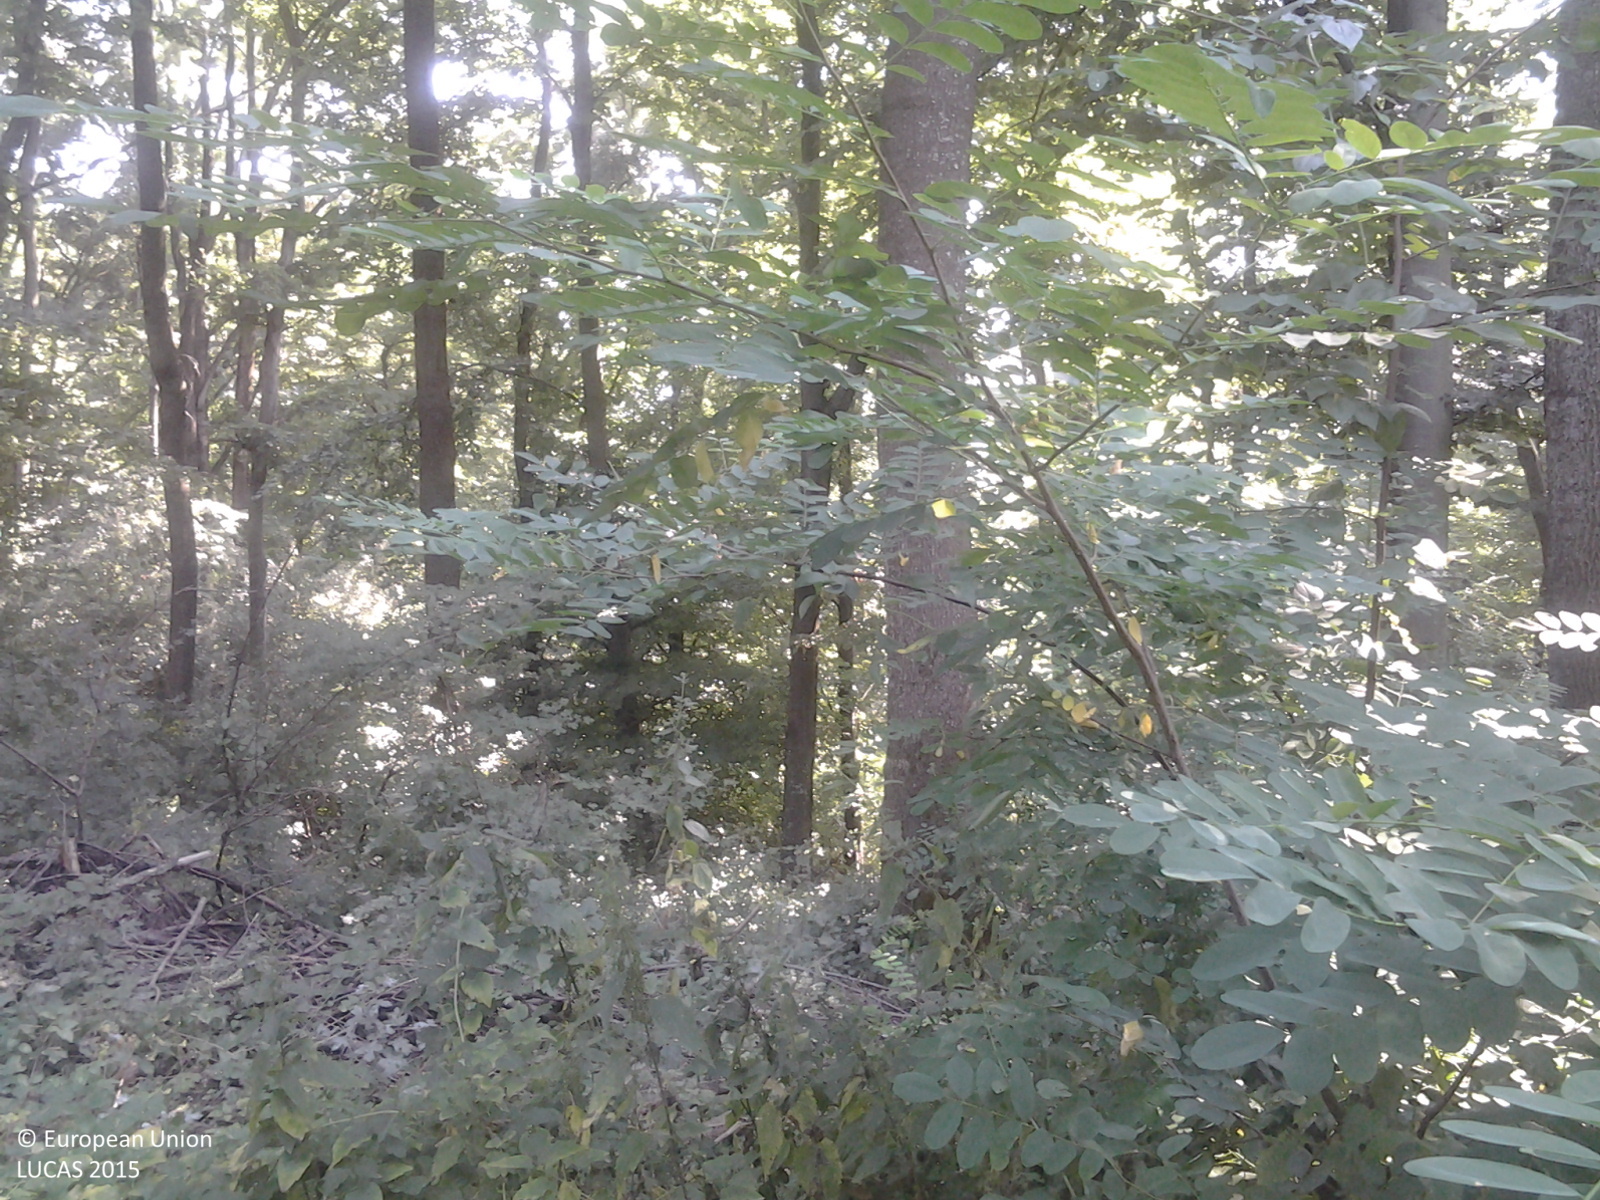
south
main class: Woodland
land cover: Broadleaved woodland
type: beech forest
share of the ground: > 75 %
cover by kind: broadleaved forest trees 90 %, herbaceous plants 10 %
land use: Forestry
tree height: > 5 m
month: August
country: HU
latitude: 46.5338
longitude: 17.0569
